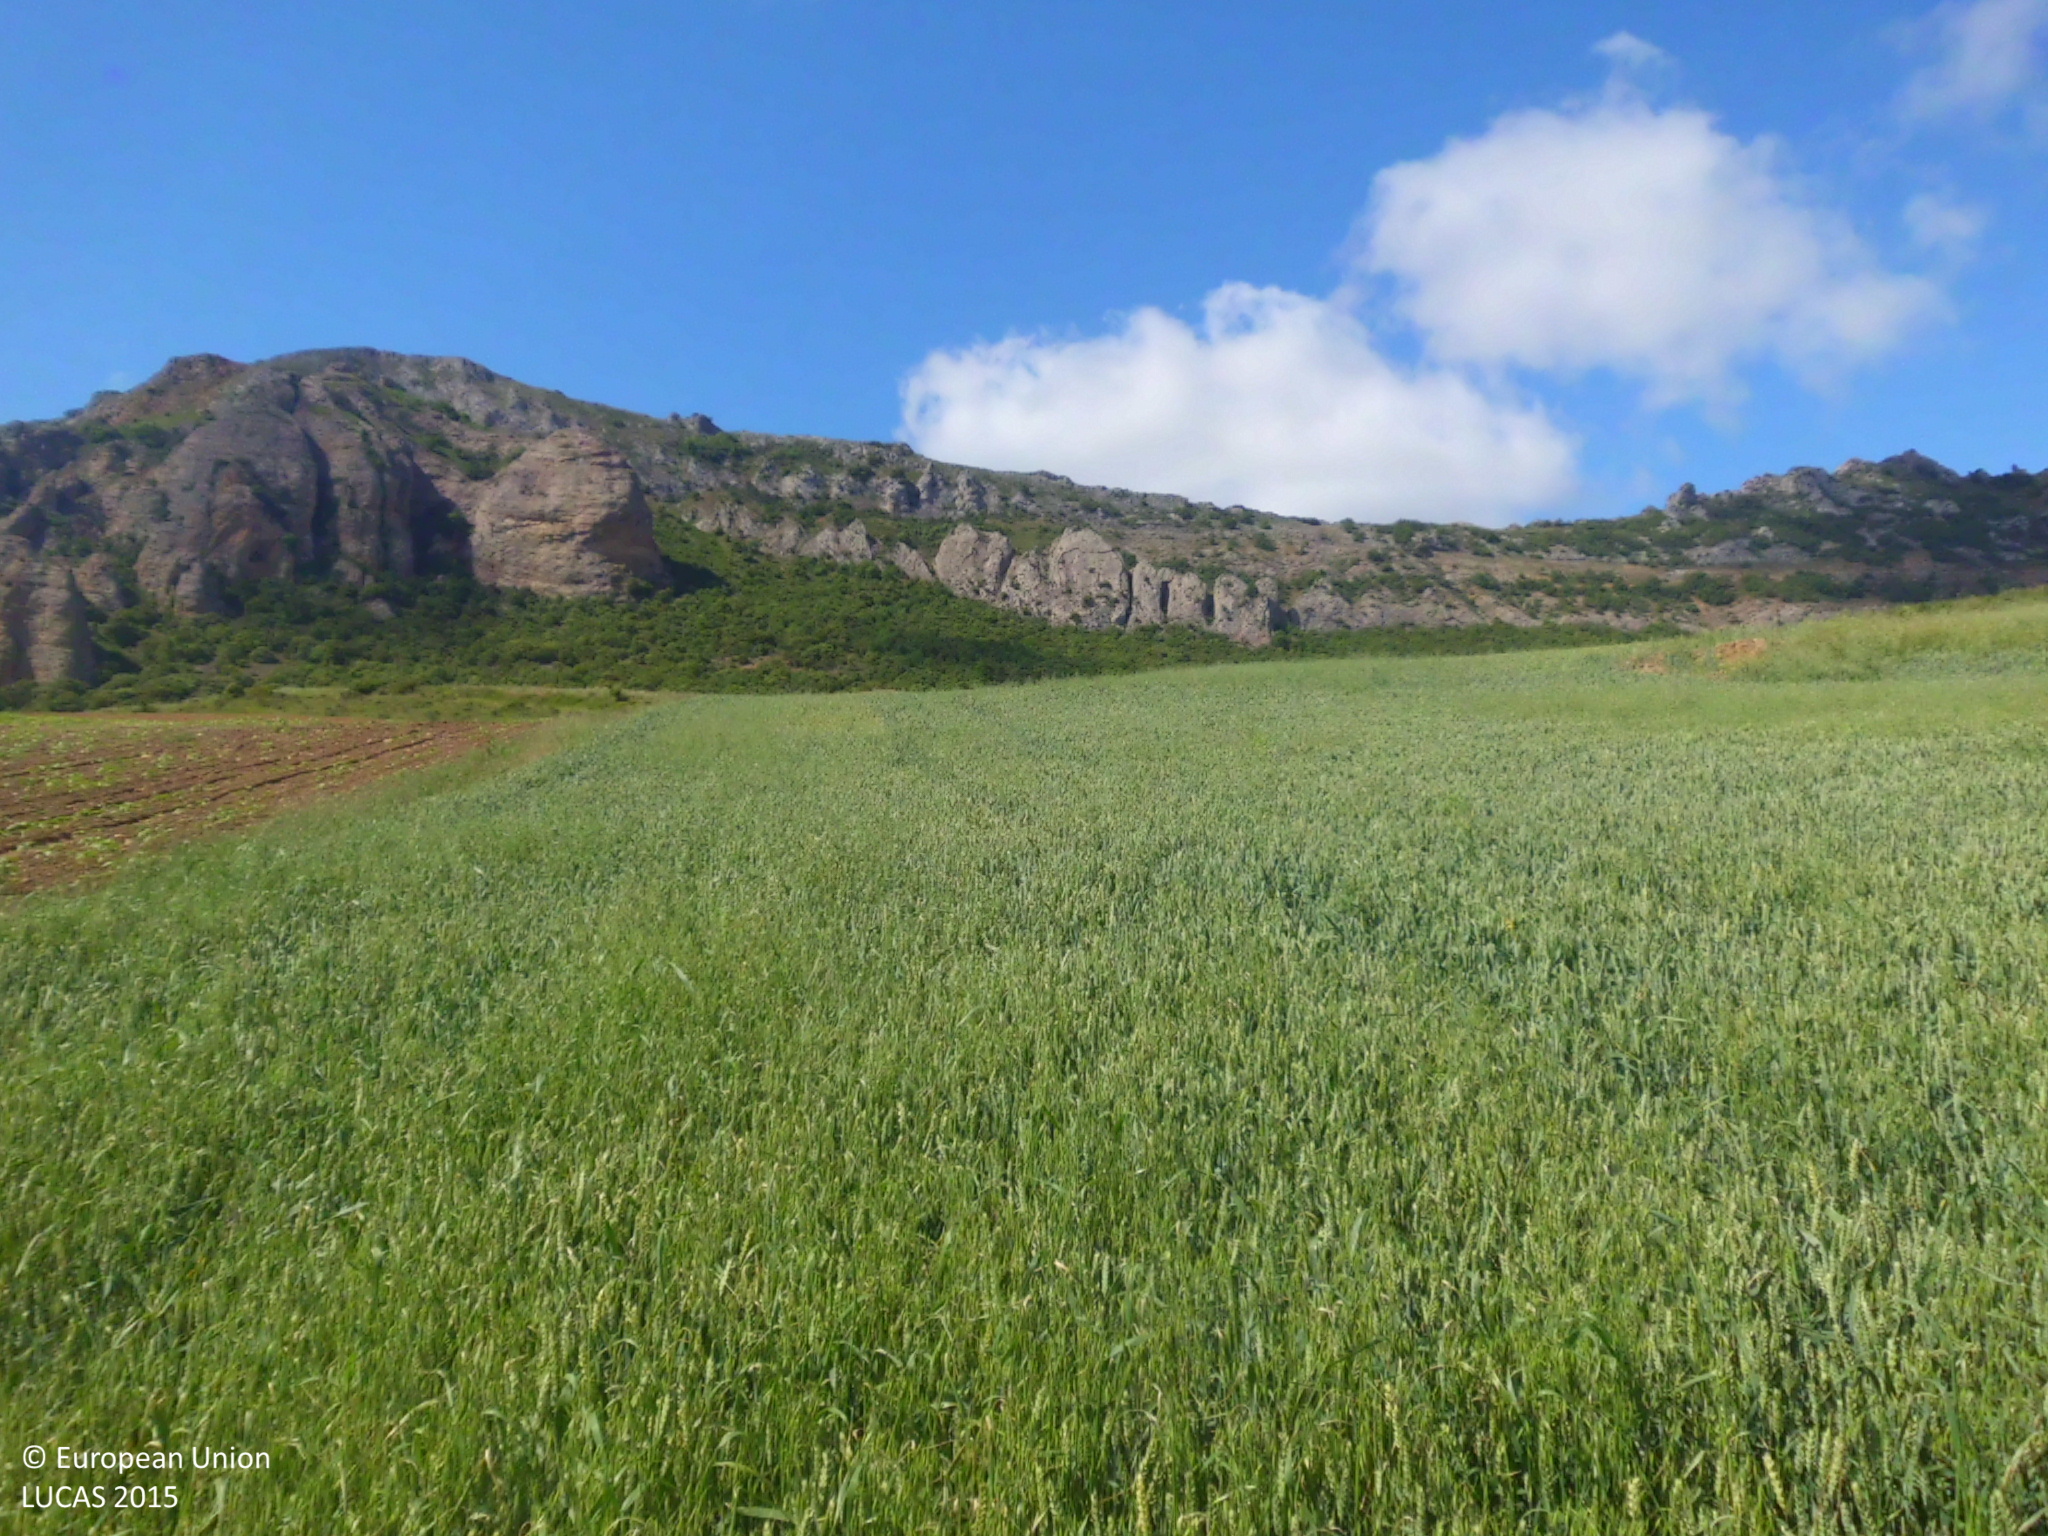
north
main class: Cropland
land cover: Common wheat
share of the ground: > 75 %
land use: Agriculture (excluding fallow land and kitchen gardens)
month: June
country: ES
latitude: 42.6863
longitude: -3.3005
